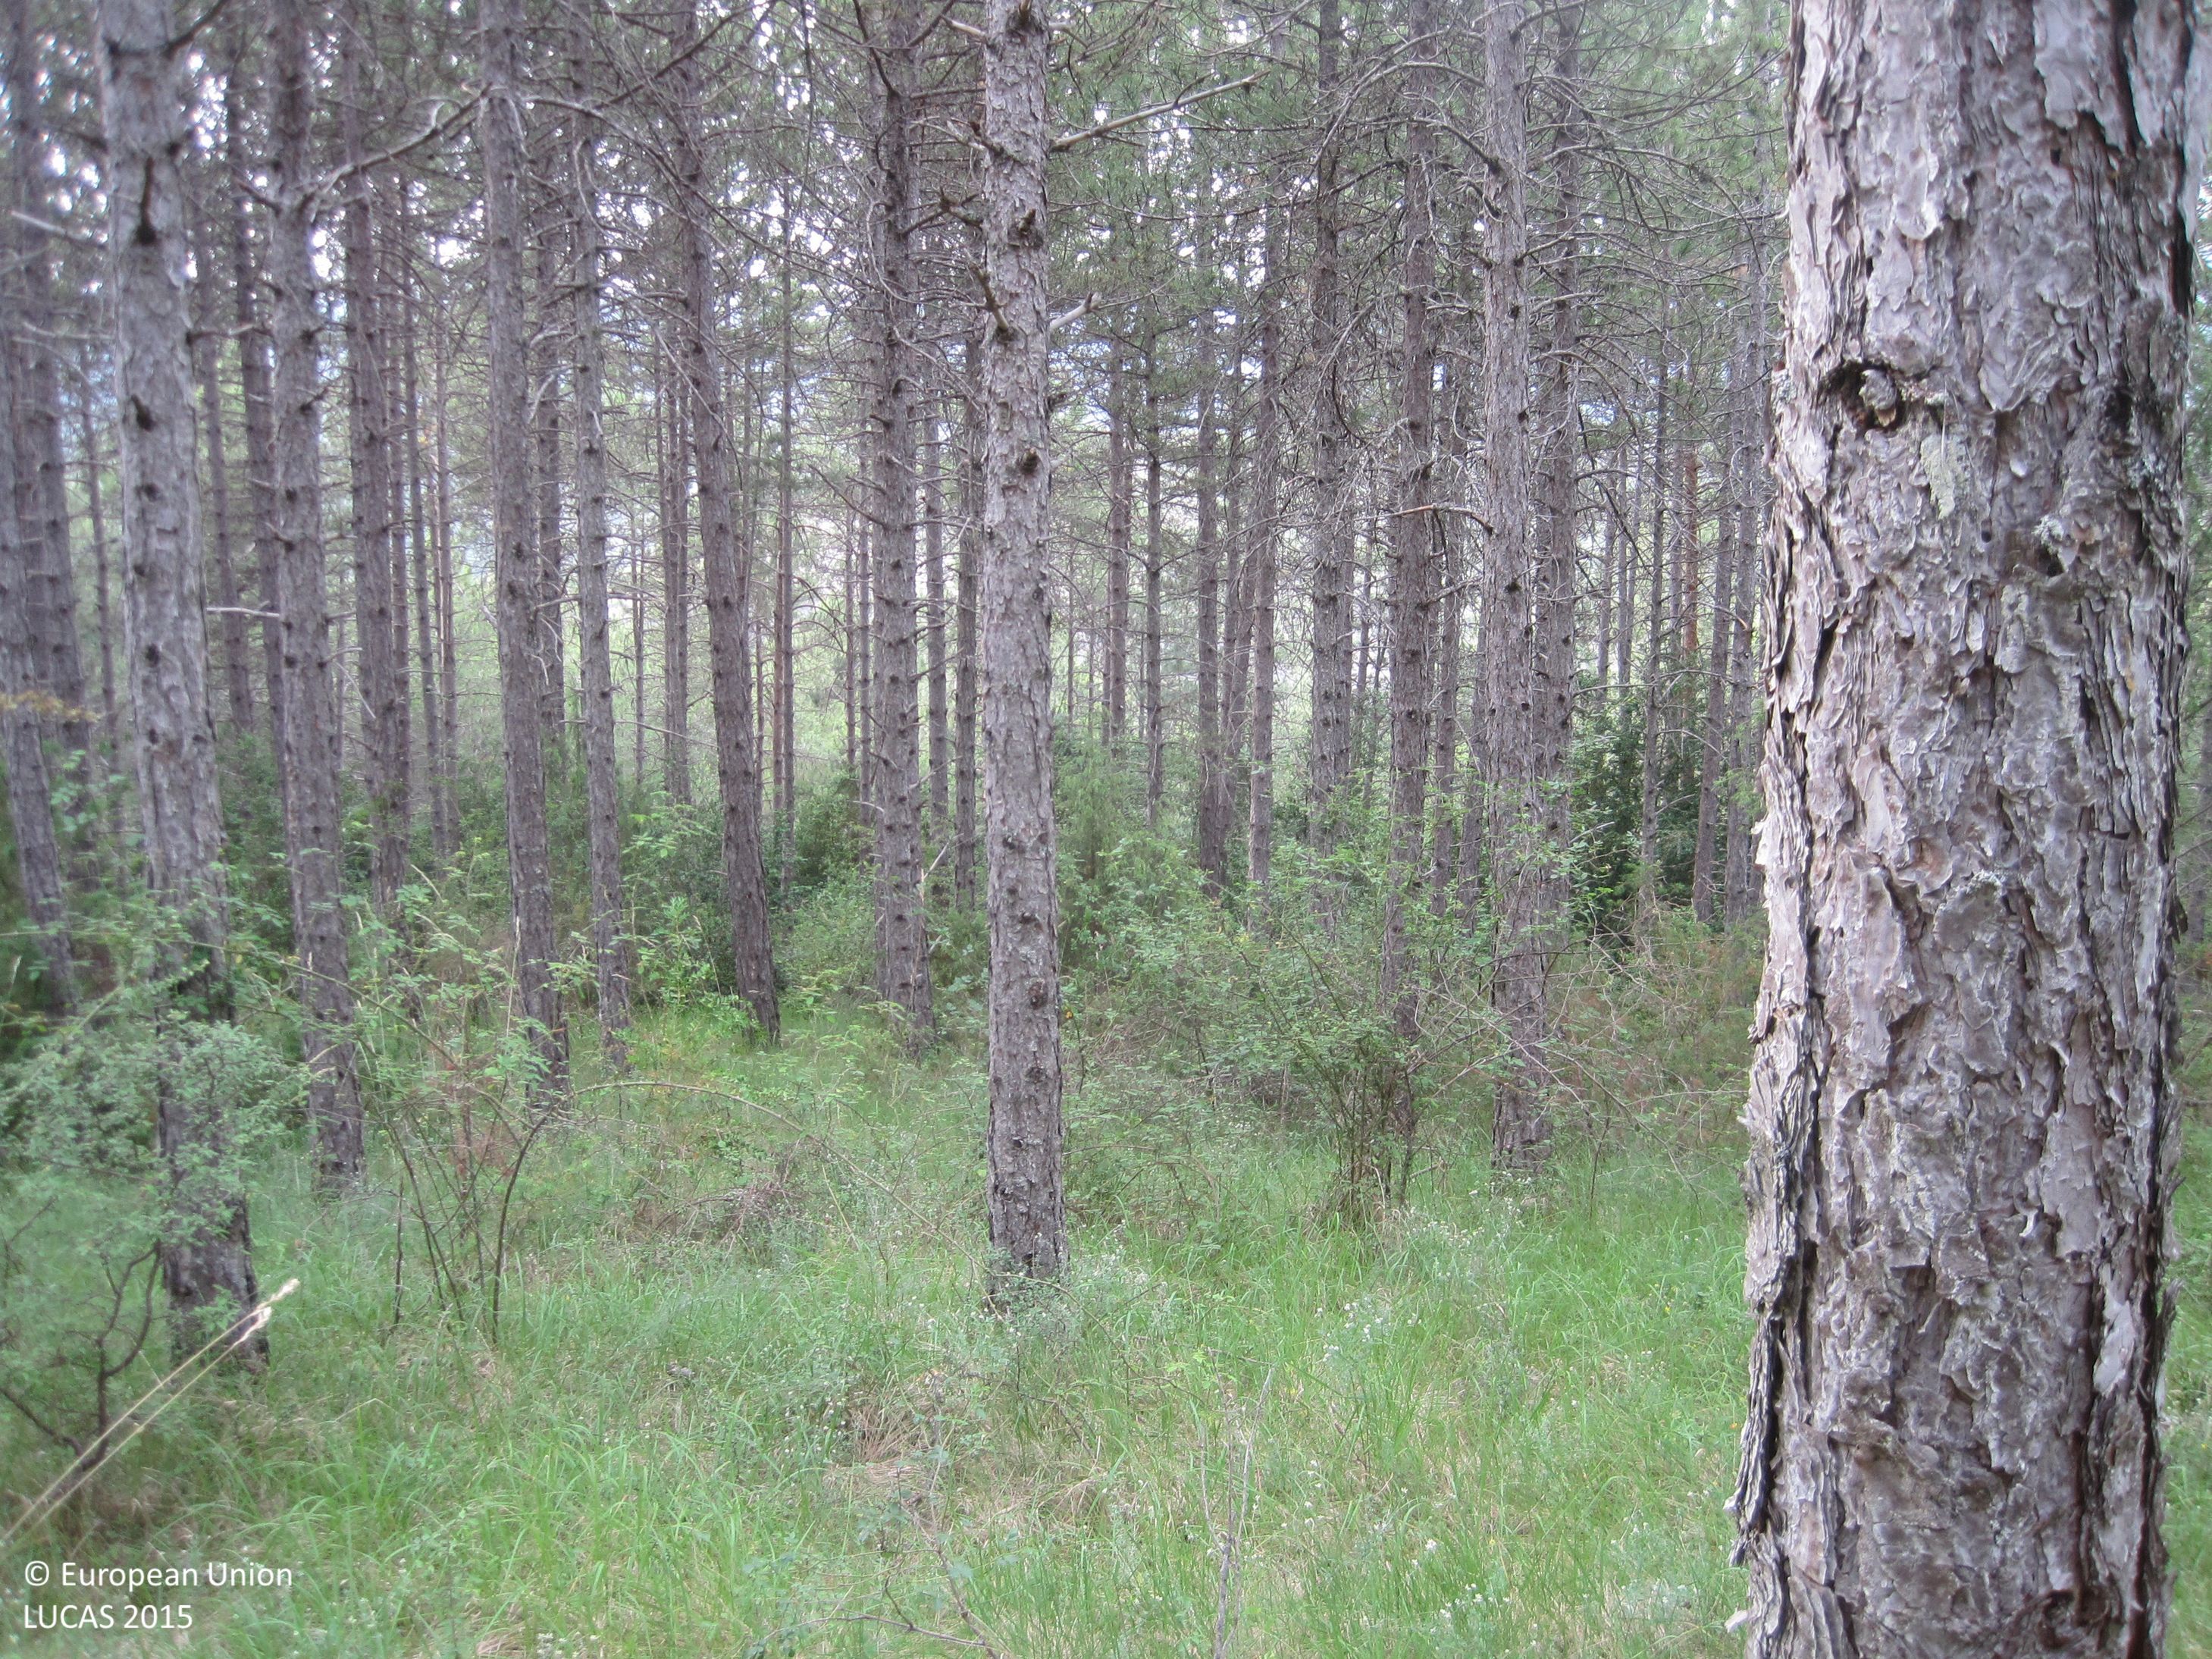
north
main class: Woodland
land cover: Pine dominated coniferous woodland
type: coniferous forest of the mediterranean region
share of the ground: > 75 %
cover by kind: coniferous forest trees 95 %, herbaceous plants 5 %
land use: Forestry
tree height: > 5 m
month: June
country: ES
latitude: 42.7729
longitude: -1.2421
